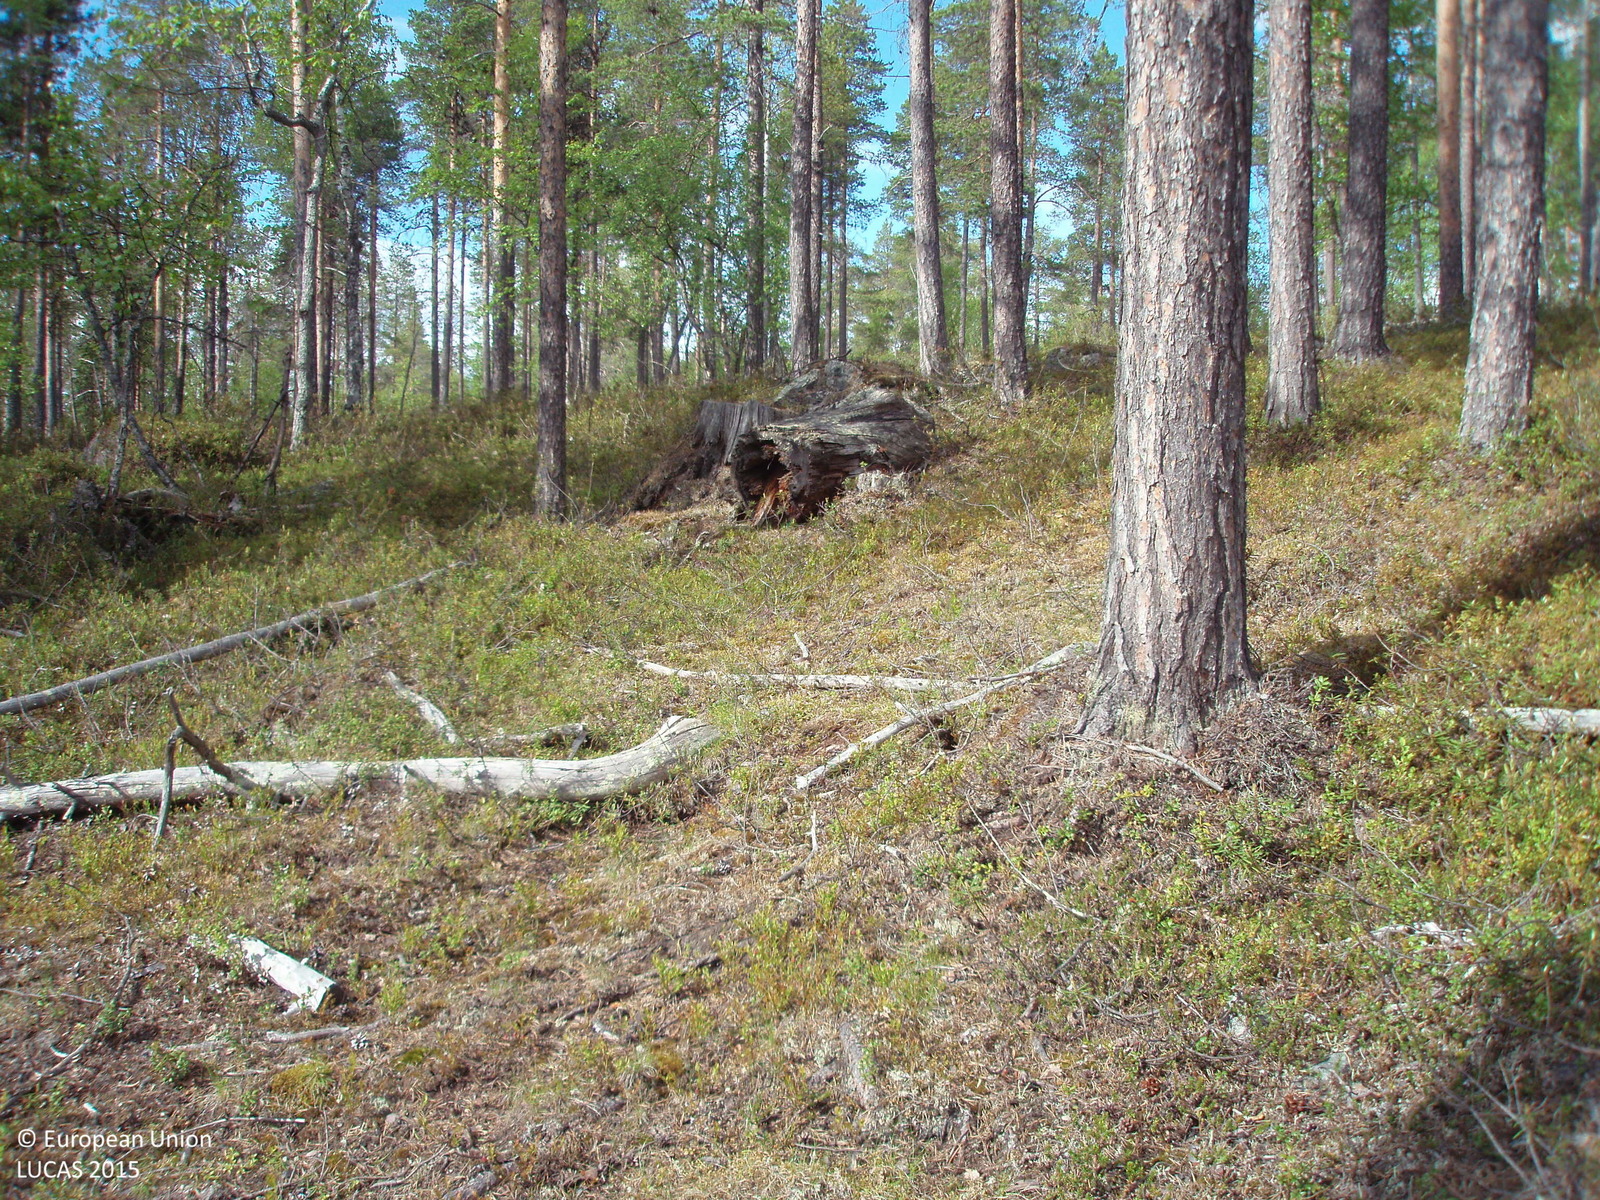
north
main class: Woodland
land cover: Pine dominated coniferous woodland
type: boreal forest
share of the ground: 50 - 75 %
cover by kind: coniferous forest trees 50 %, shrubs 35 %, broadleaved forest trees 10 %, lichens and mosses 5 %
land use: Forestry
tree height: > 5 m
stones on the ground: 25 - 50 %
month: June
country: FI
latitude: 68.7596
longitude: 28.3793
